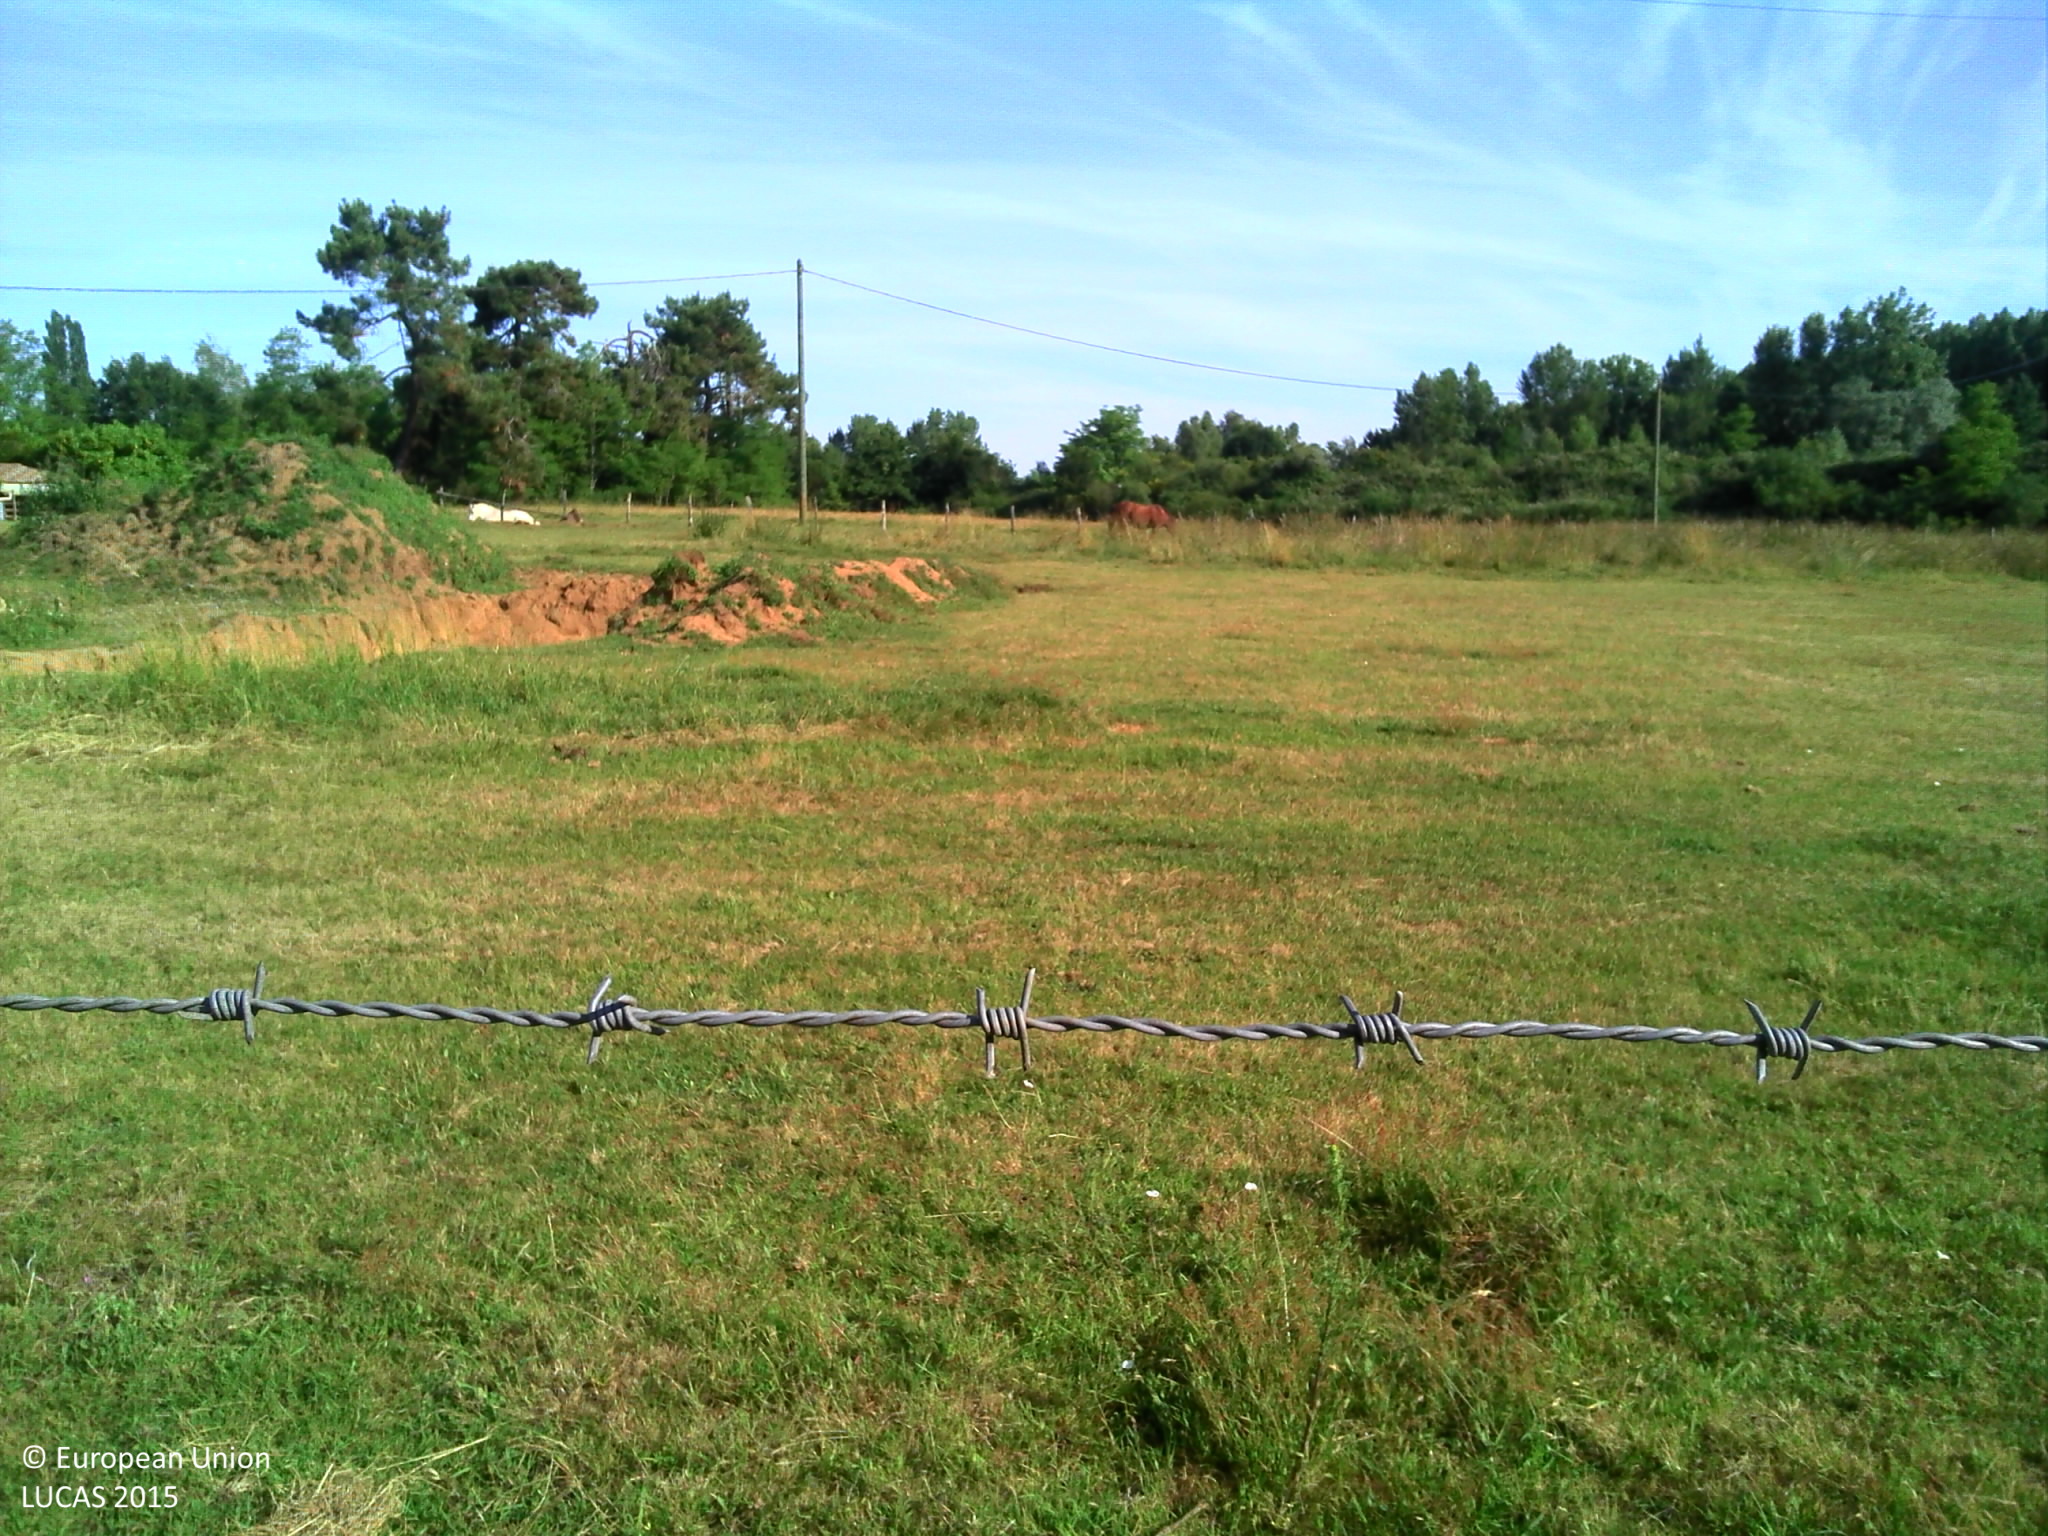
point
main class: Grassland
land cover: Grassland without tree/shrub cover
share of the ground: > 75 %
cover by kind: herbaceous plants 100 %
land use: Agriculture (excluding fallow land and kitchen gardens)
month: June
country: FR
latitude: 48.0488
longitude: 0.3024
